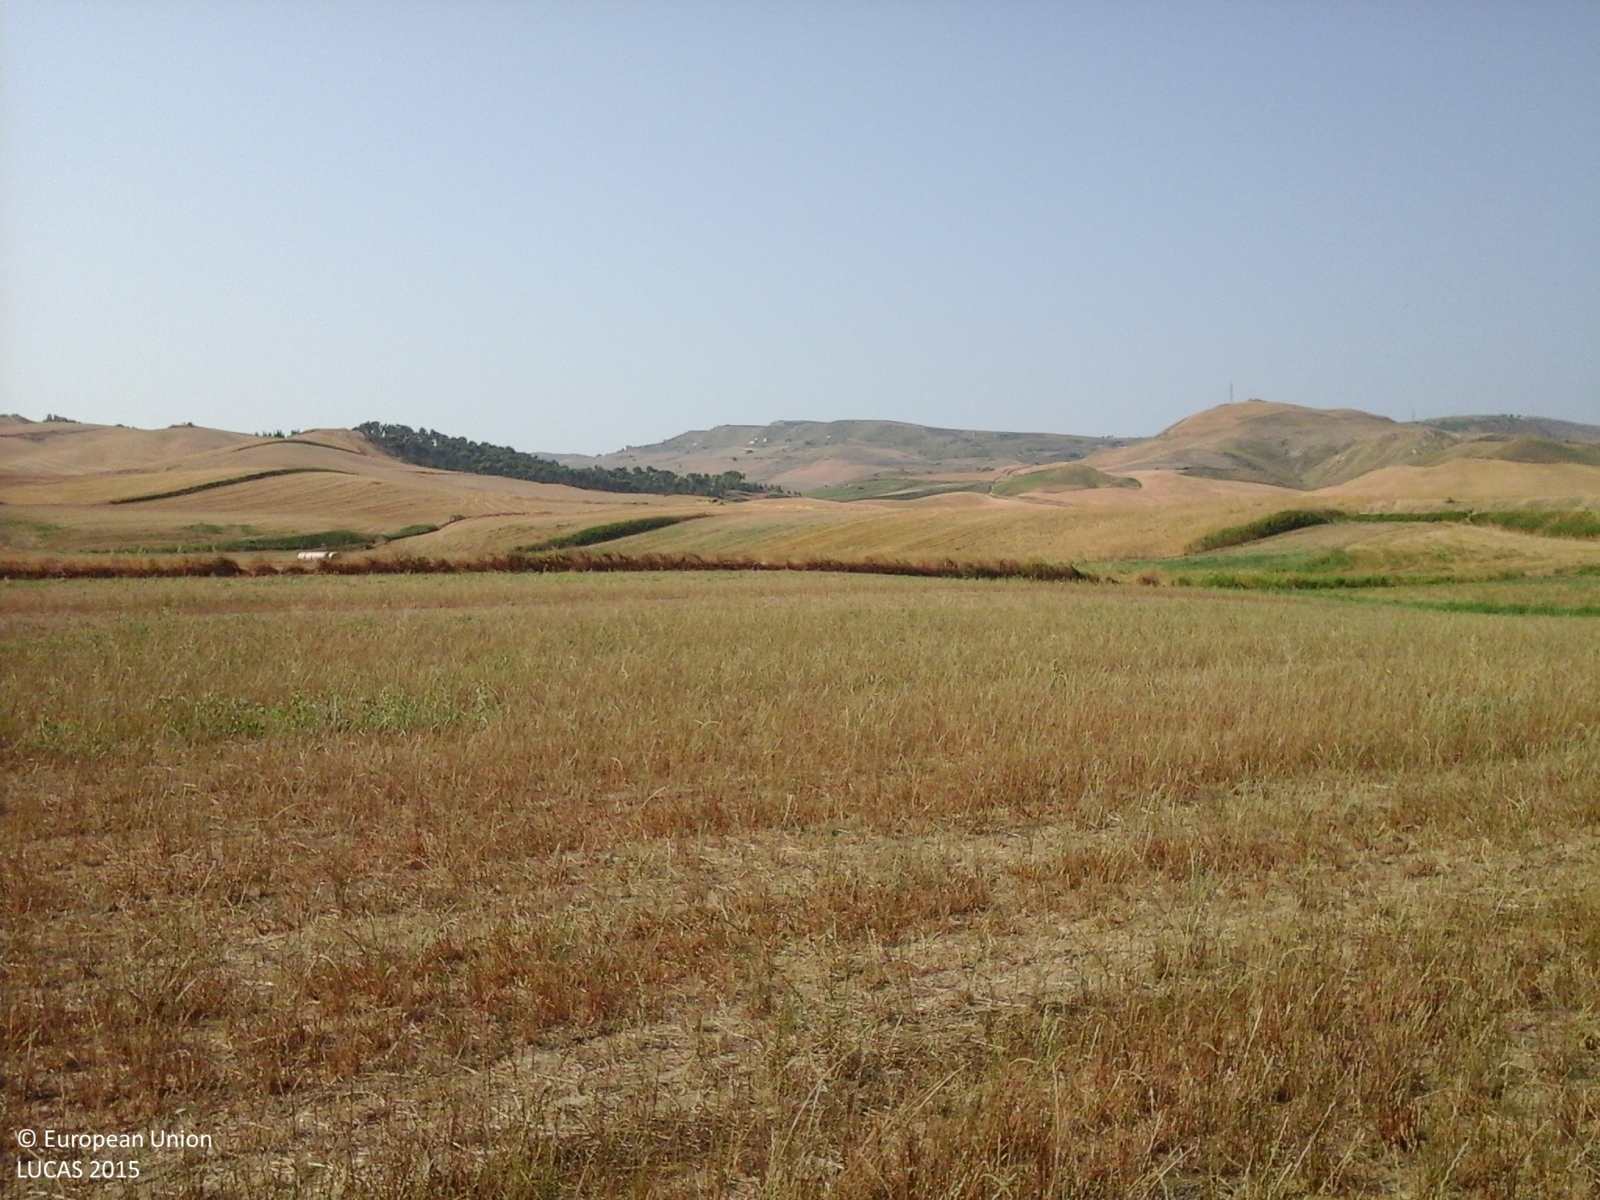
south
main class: Cropland
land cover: Durum wheat
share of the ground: > 75 %
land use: Agriculture (excluding fallow land and kitchen gardens)
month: July
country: IT
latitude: 37.1912
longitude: 13.9904
